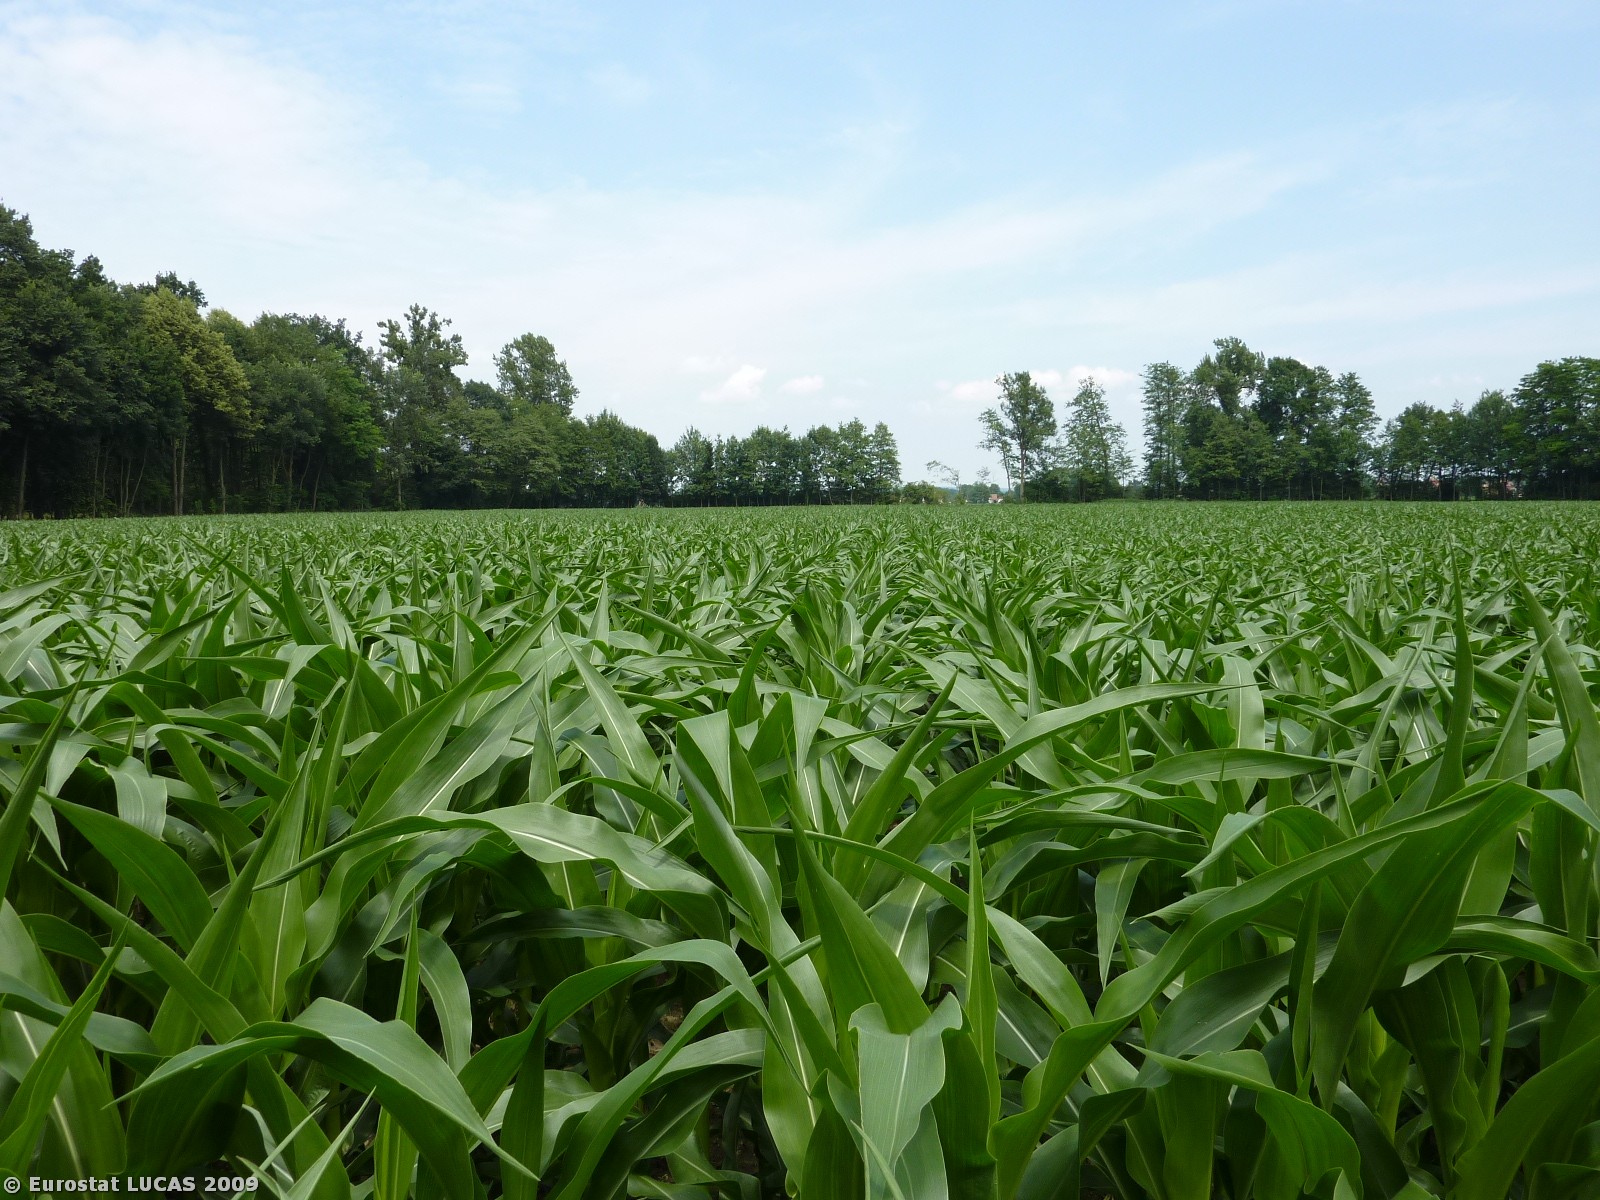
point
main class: Cropland
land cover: Maize
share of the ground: > 75 %
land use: Agriculture (excluding fallow land and kitchen gardens)
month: June
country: AT
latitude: 46.7053
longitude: 15.6891
